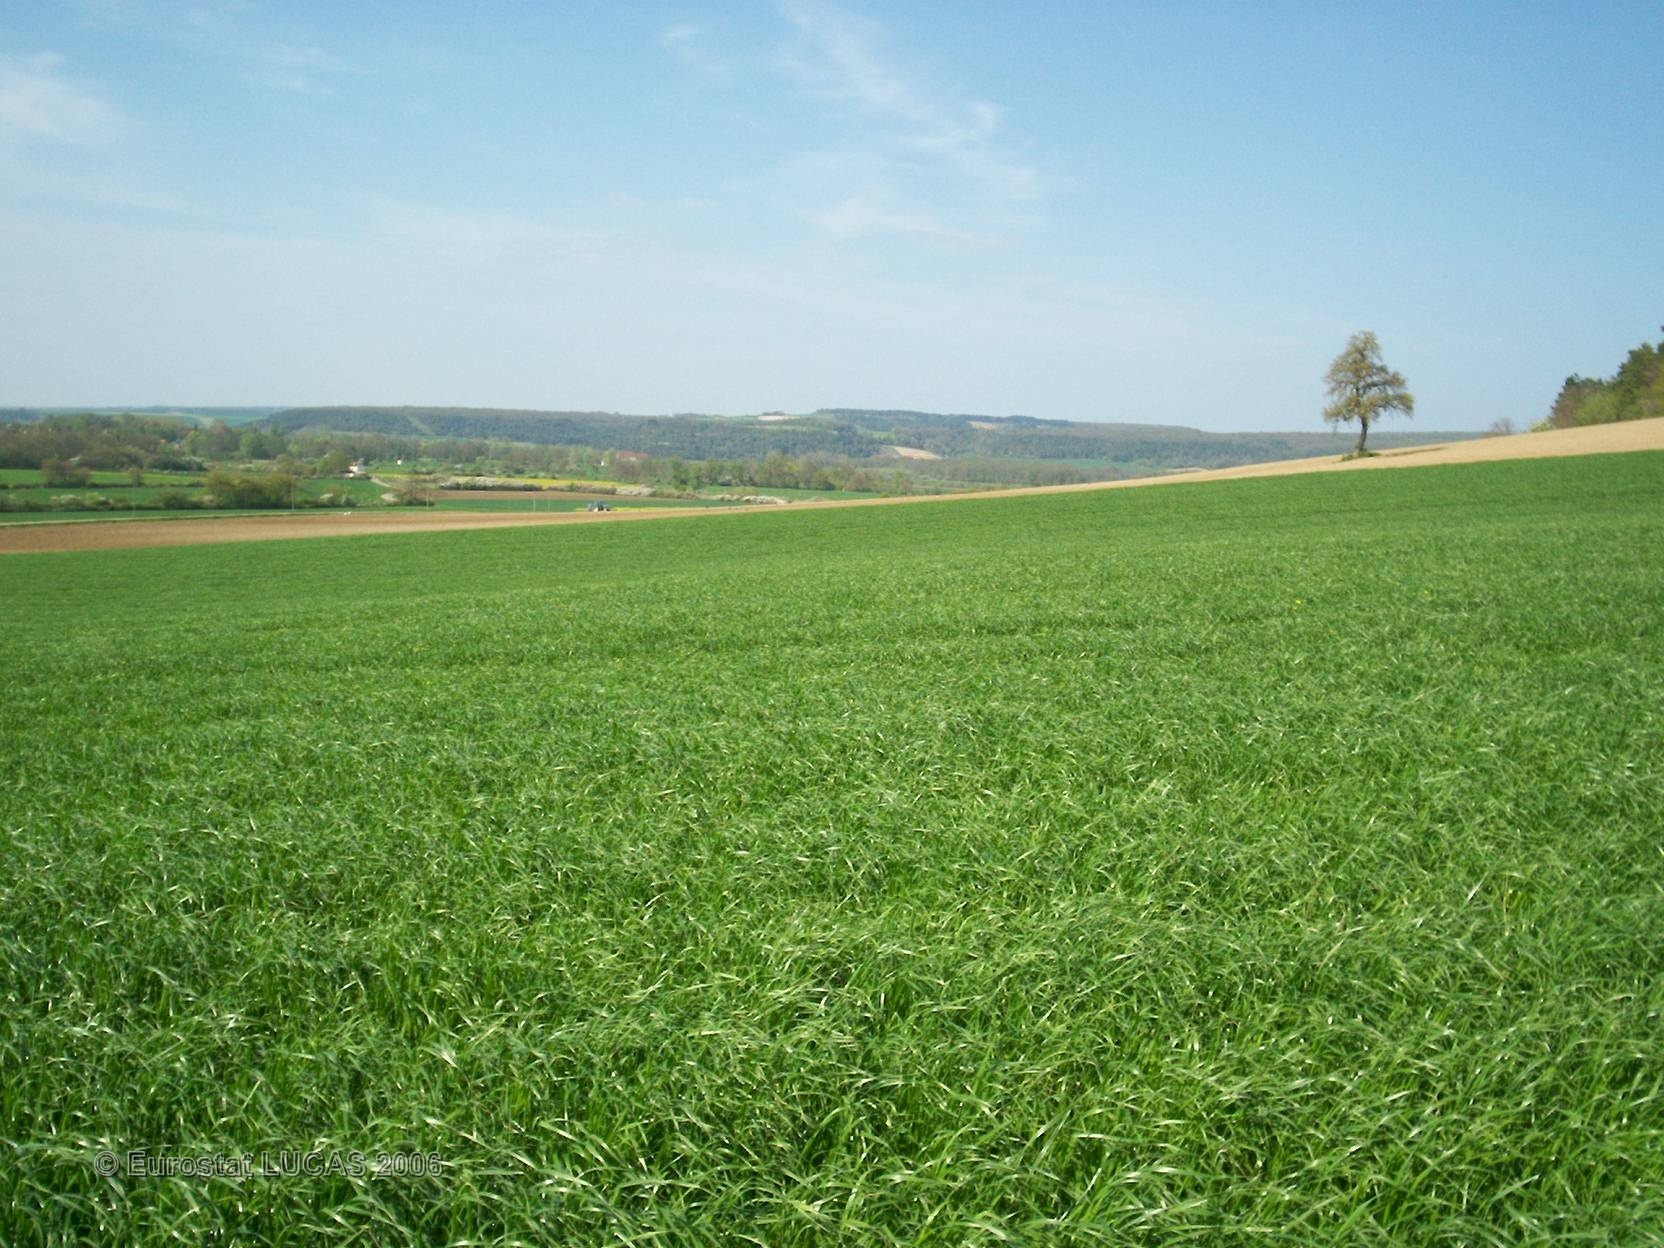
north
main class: Cropland
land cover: Barley
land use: Agriculture (excluding fallow land and kitchen gardens)
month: April
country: FR
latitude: 47.9072
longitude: 4.5264
